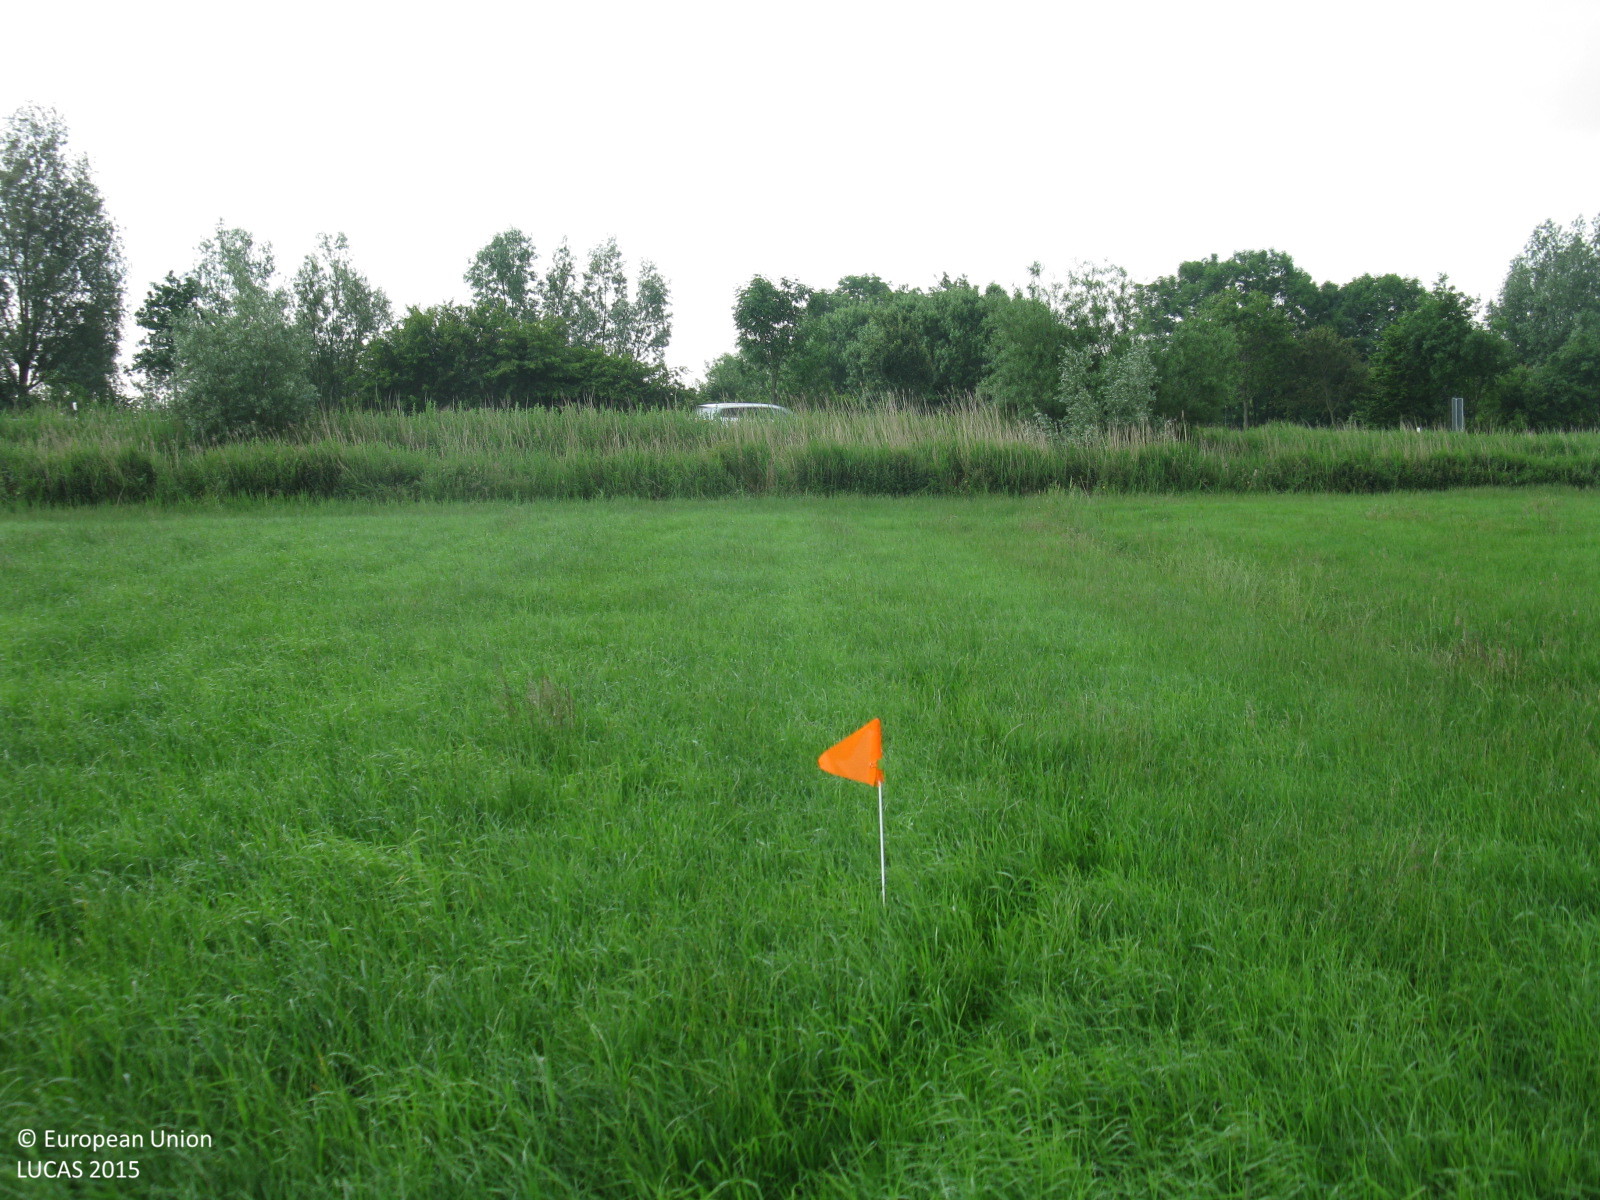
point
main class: Grassland
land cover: Grassland without tree/shrub cover
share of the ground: > 75 %
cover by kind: herbaceous plants 100 %
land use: Agriculture (excluding fallow land and kitchen gardens)
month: June
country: DE
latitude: 53.5810
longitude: 7.8710
